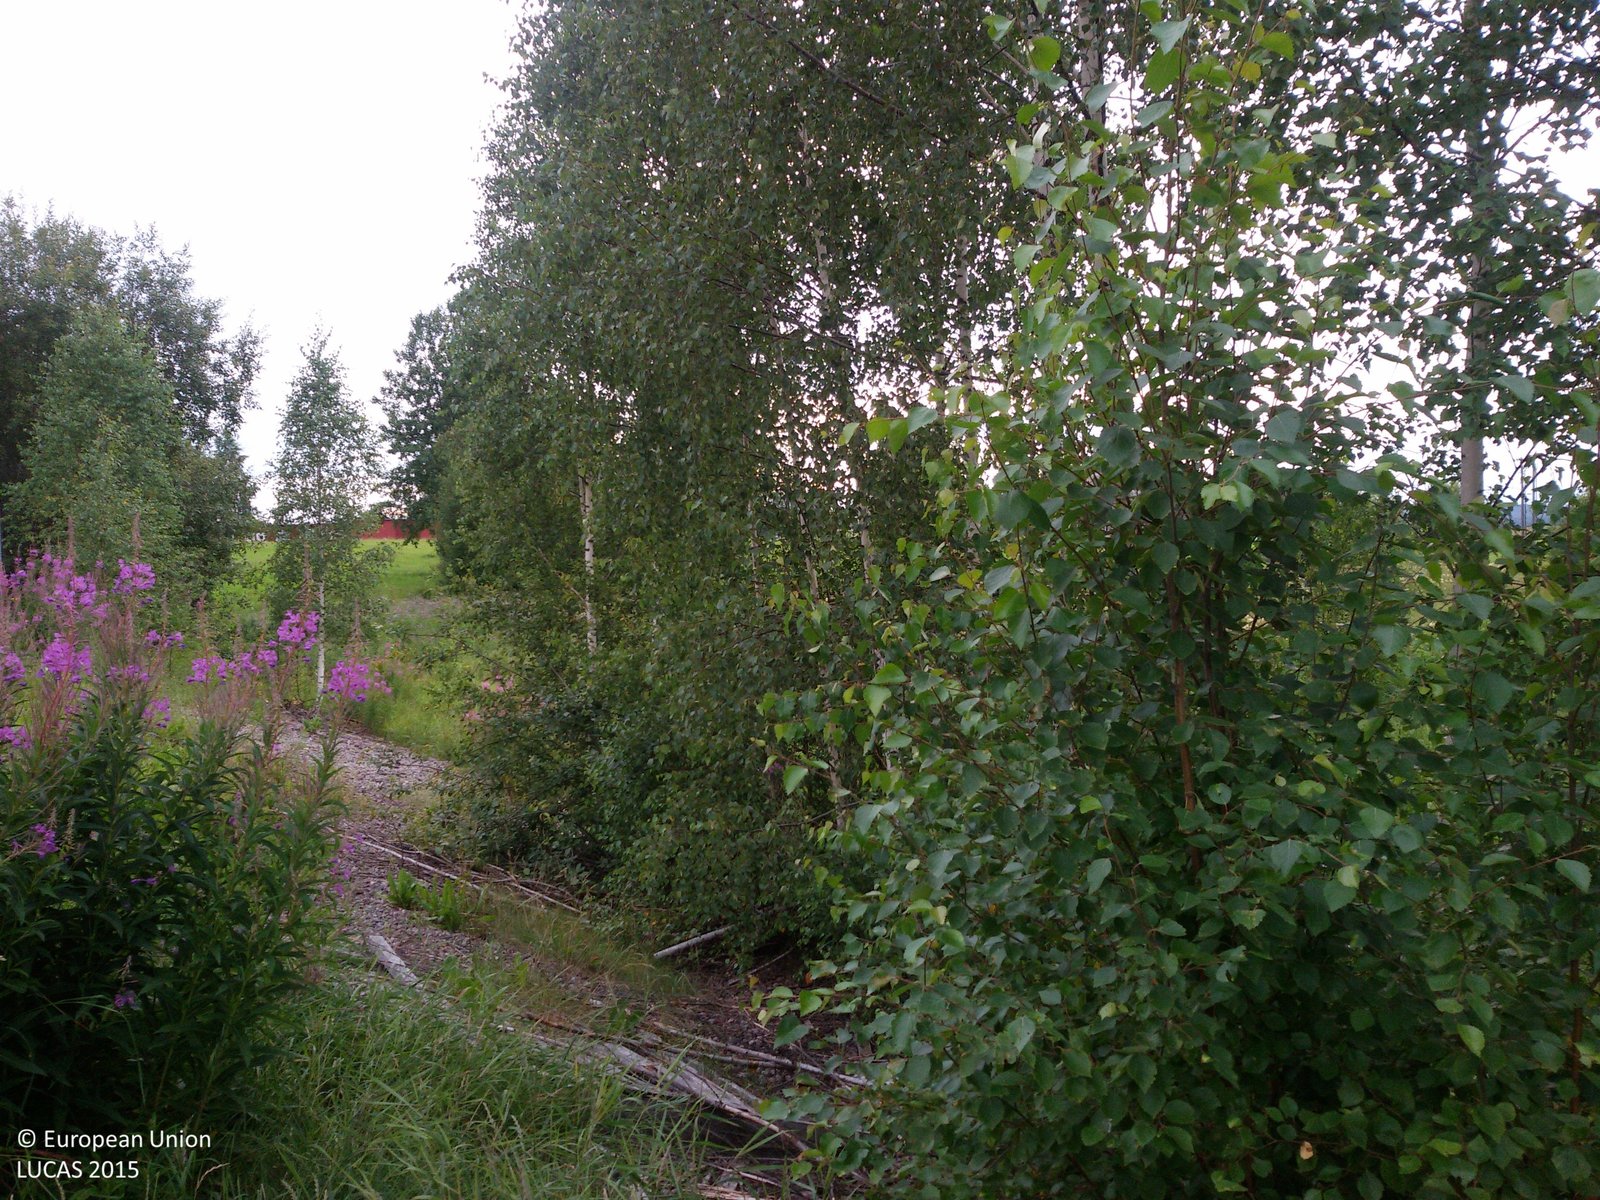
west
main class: Grassland
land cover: Spontaneously vegetated surfaces
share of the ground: > 75 %
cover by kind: herbaceous plants 100 %
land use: Semi-natural and natural areas not in use
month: July
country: SE
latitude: 60.4039
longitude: 15.8149
